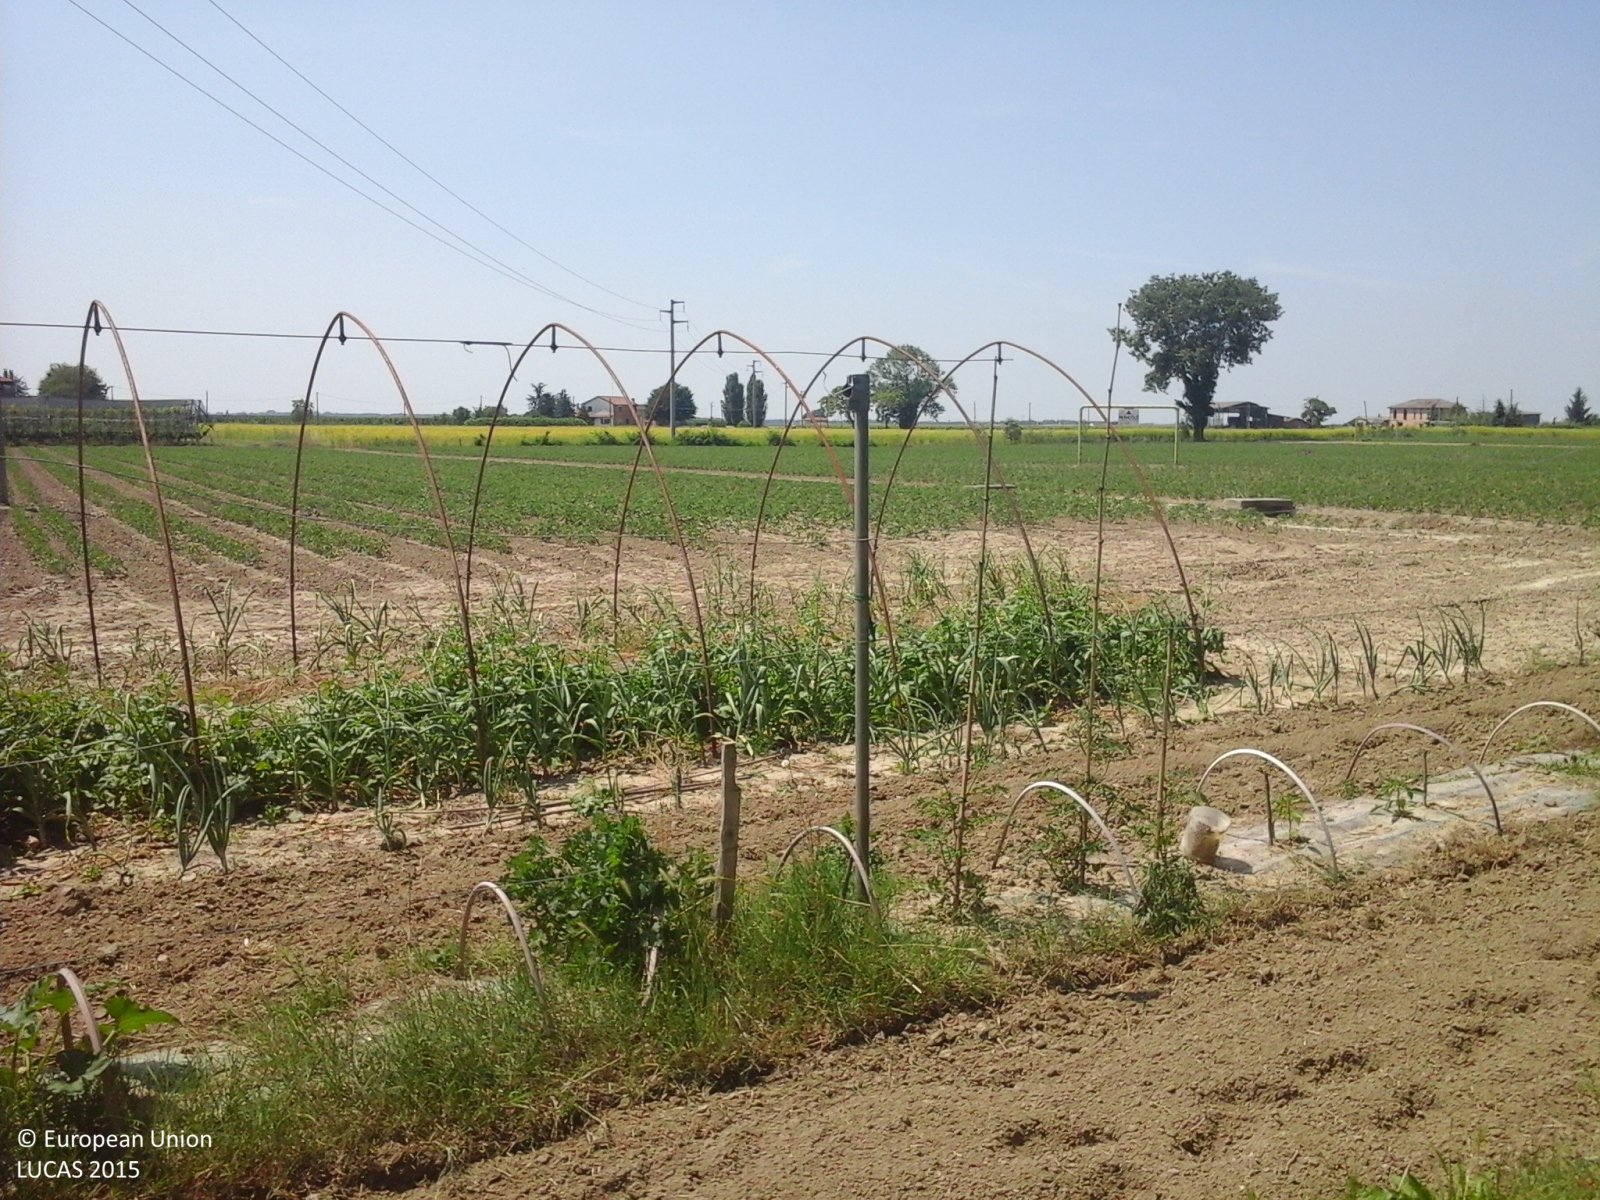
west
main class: Woodland
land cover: Broadleaved woodland
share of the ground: > 75 %
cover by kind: broadleaved forest trees 100 %
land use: Residential
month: June
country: IT
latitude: 44.6033
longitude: 11.9237
